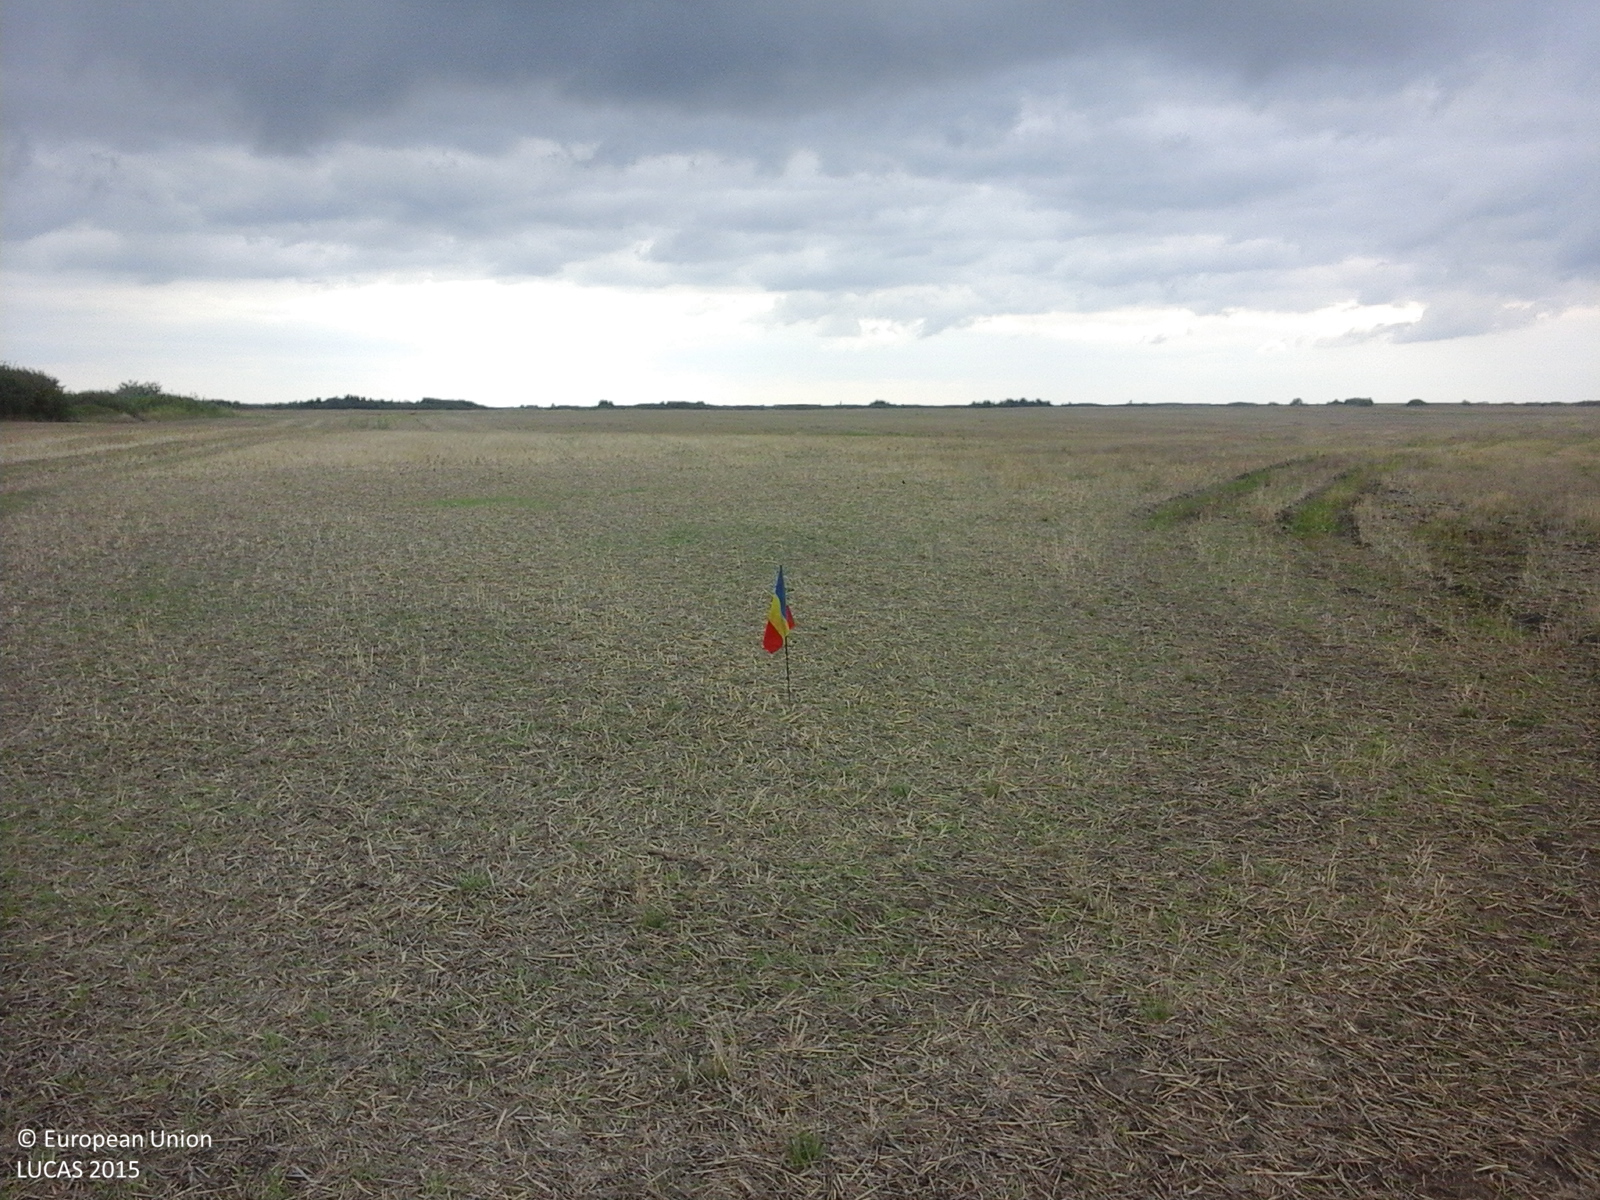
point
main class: Cropland
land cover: Common wheat
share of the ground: 25 - 50 %
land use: Agriculture (excluding fallow land and kitchen gardens)
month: August
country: RO
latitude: 45.4076
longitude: 21.1047
